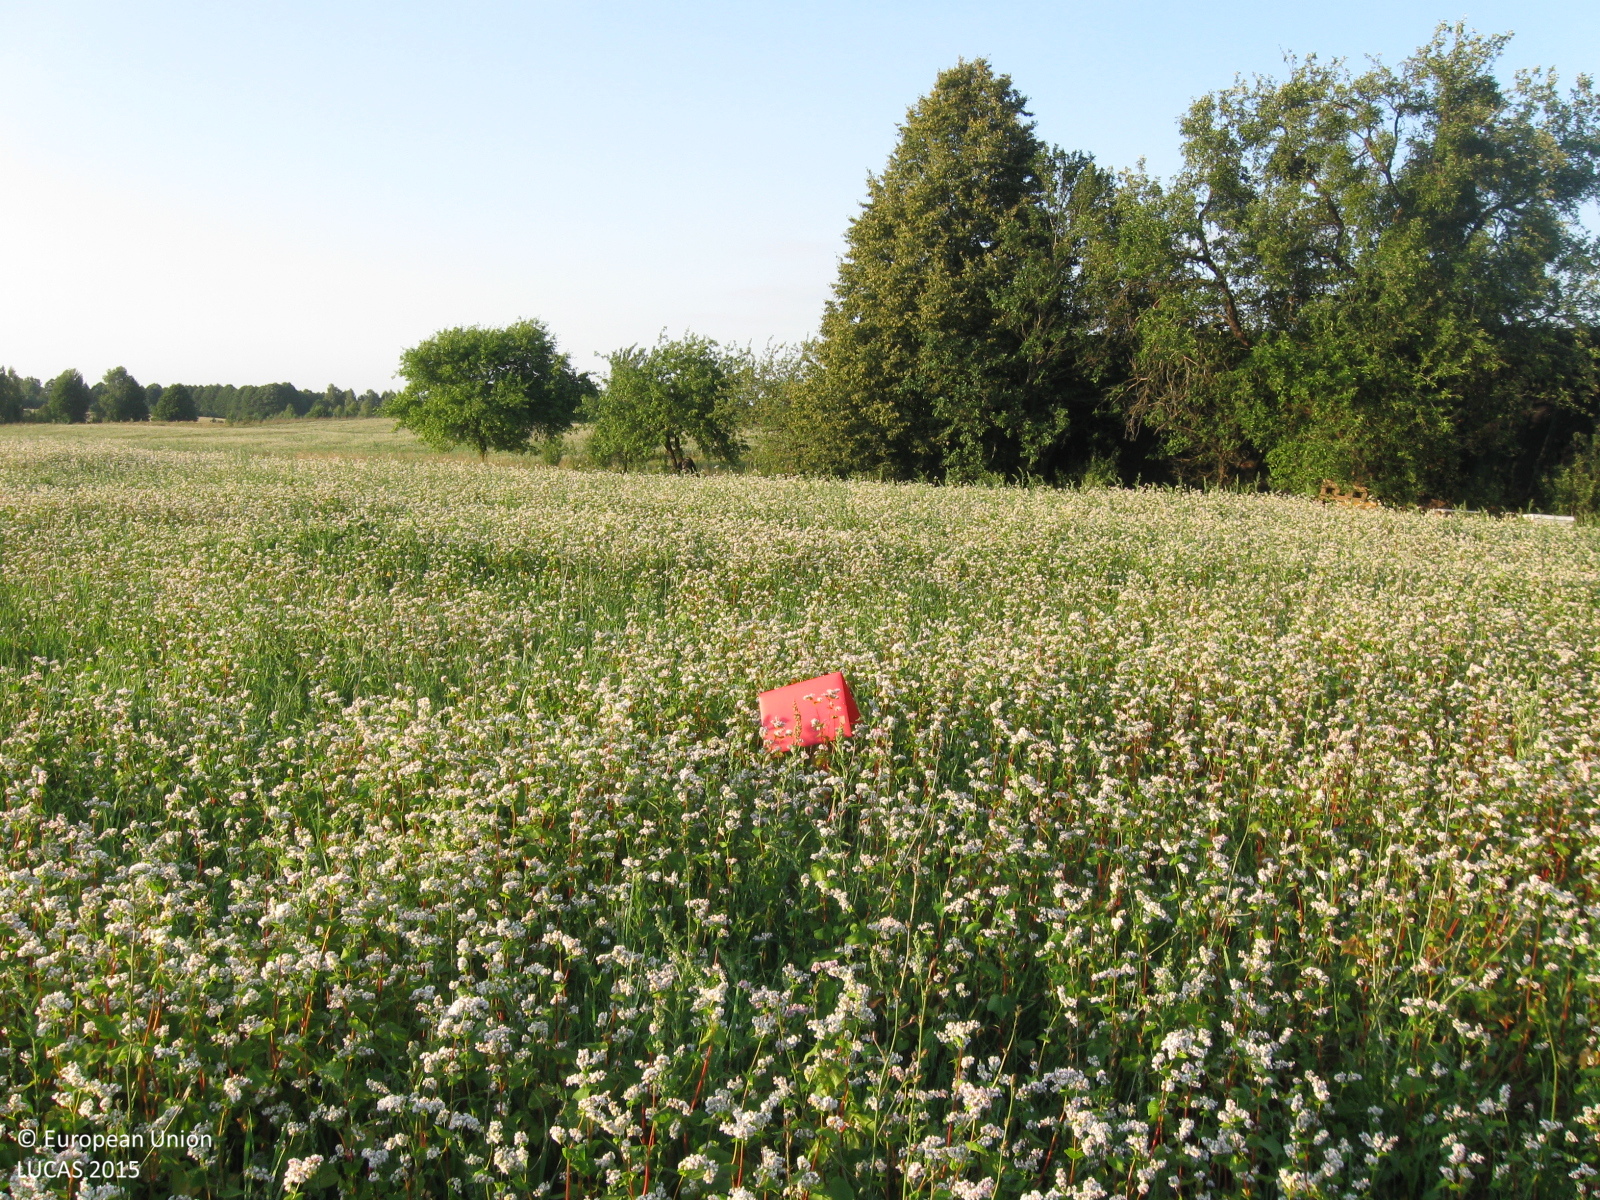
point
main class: Cropland
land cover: Other cereals
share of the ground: > 75 %
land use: Agriculture (excluding fallow land and kitchen gardens)
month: July
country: LT
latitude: 54.0746
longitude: 23.7352
